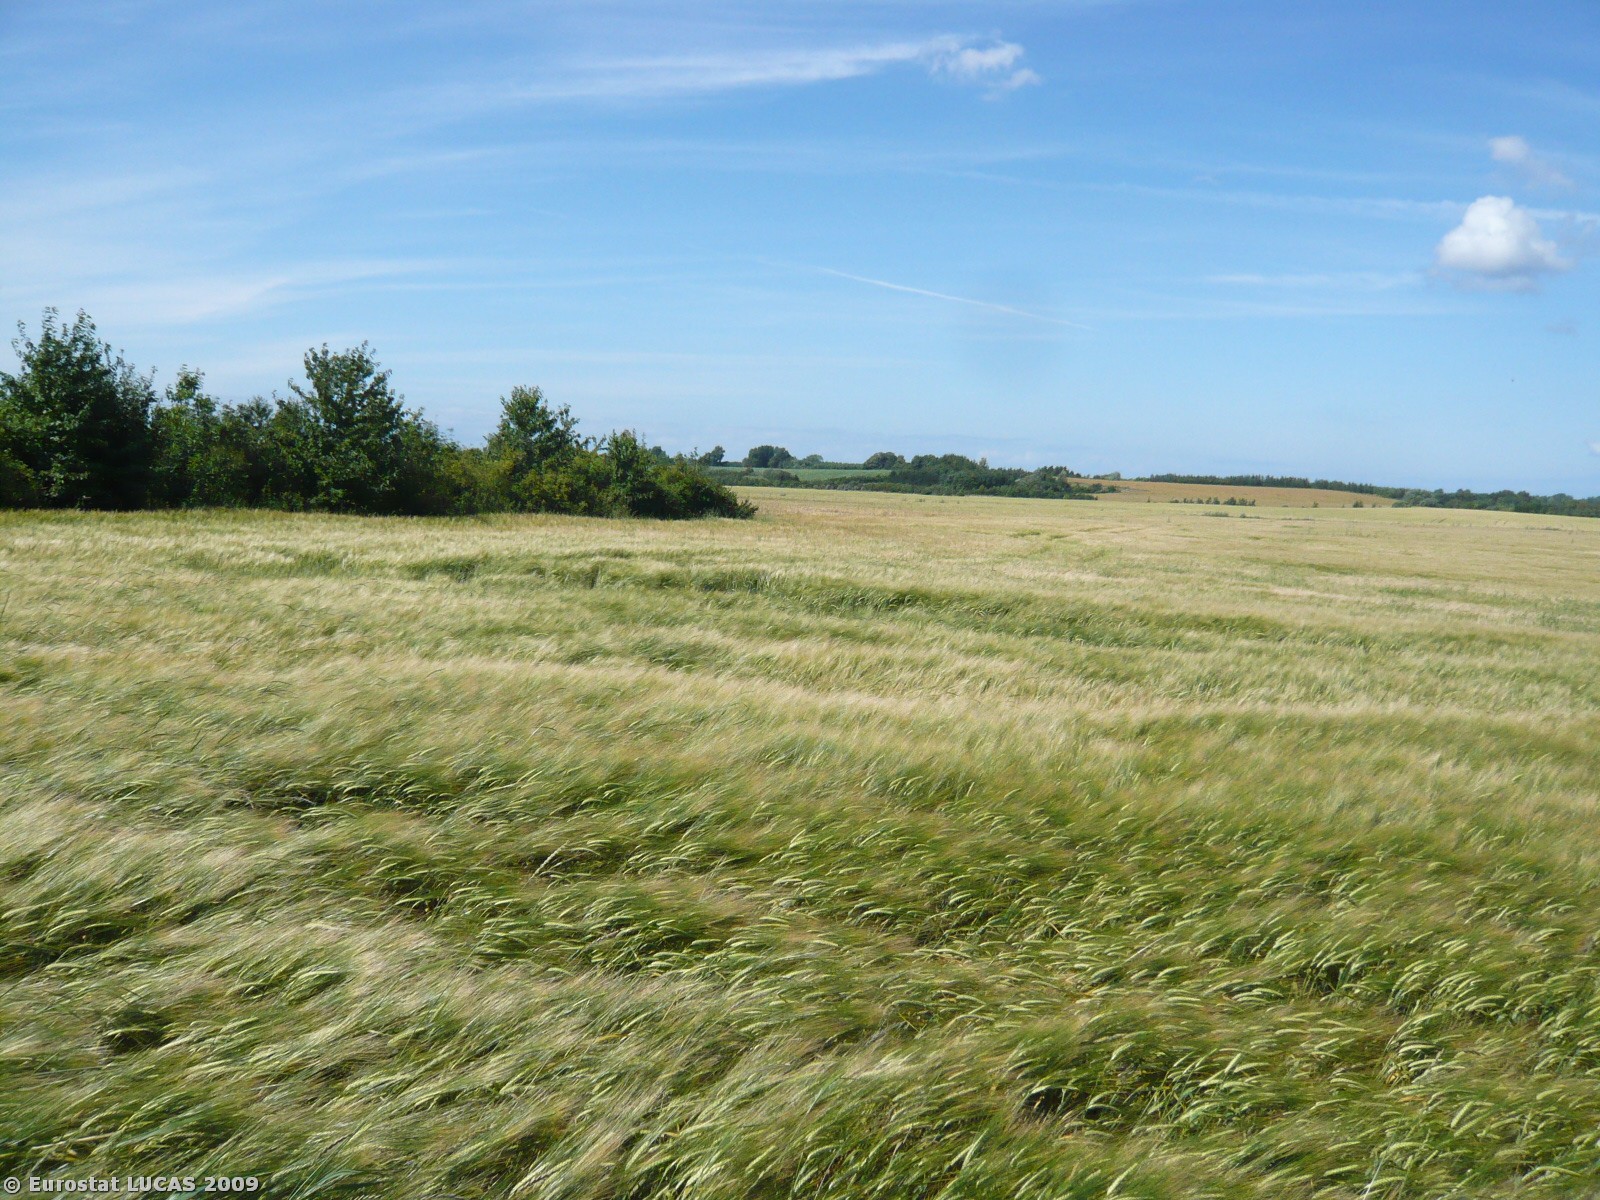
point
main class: Cropland
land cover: Barley
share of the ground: > 75 %
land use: Agriculture (excluding fallow land and kitchen gardens)
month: July
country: DK
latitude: 55.6974
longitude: 11.1285
